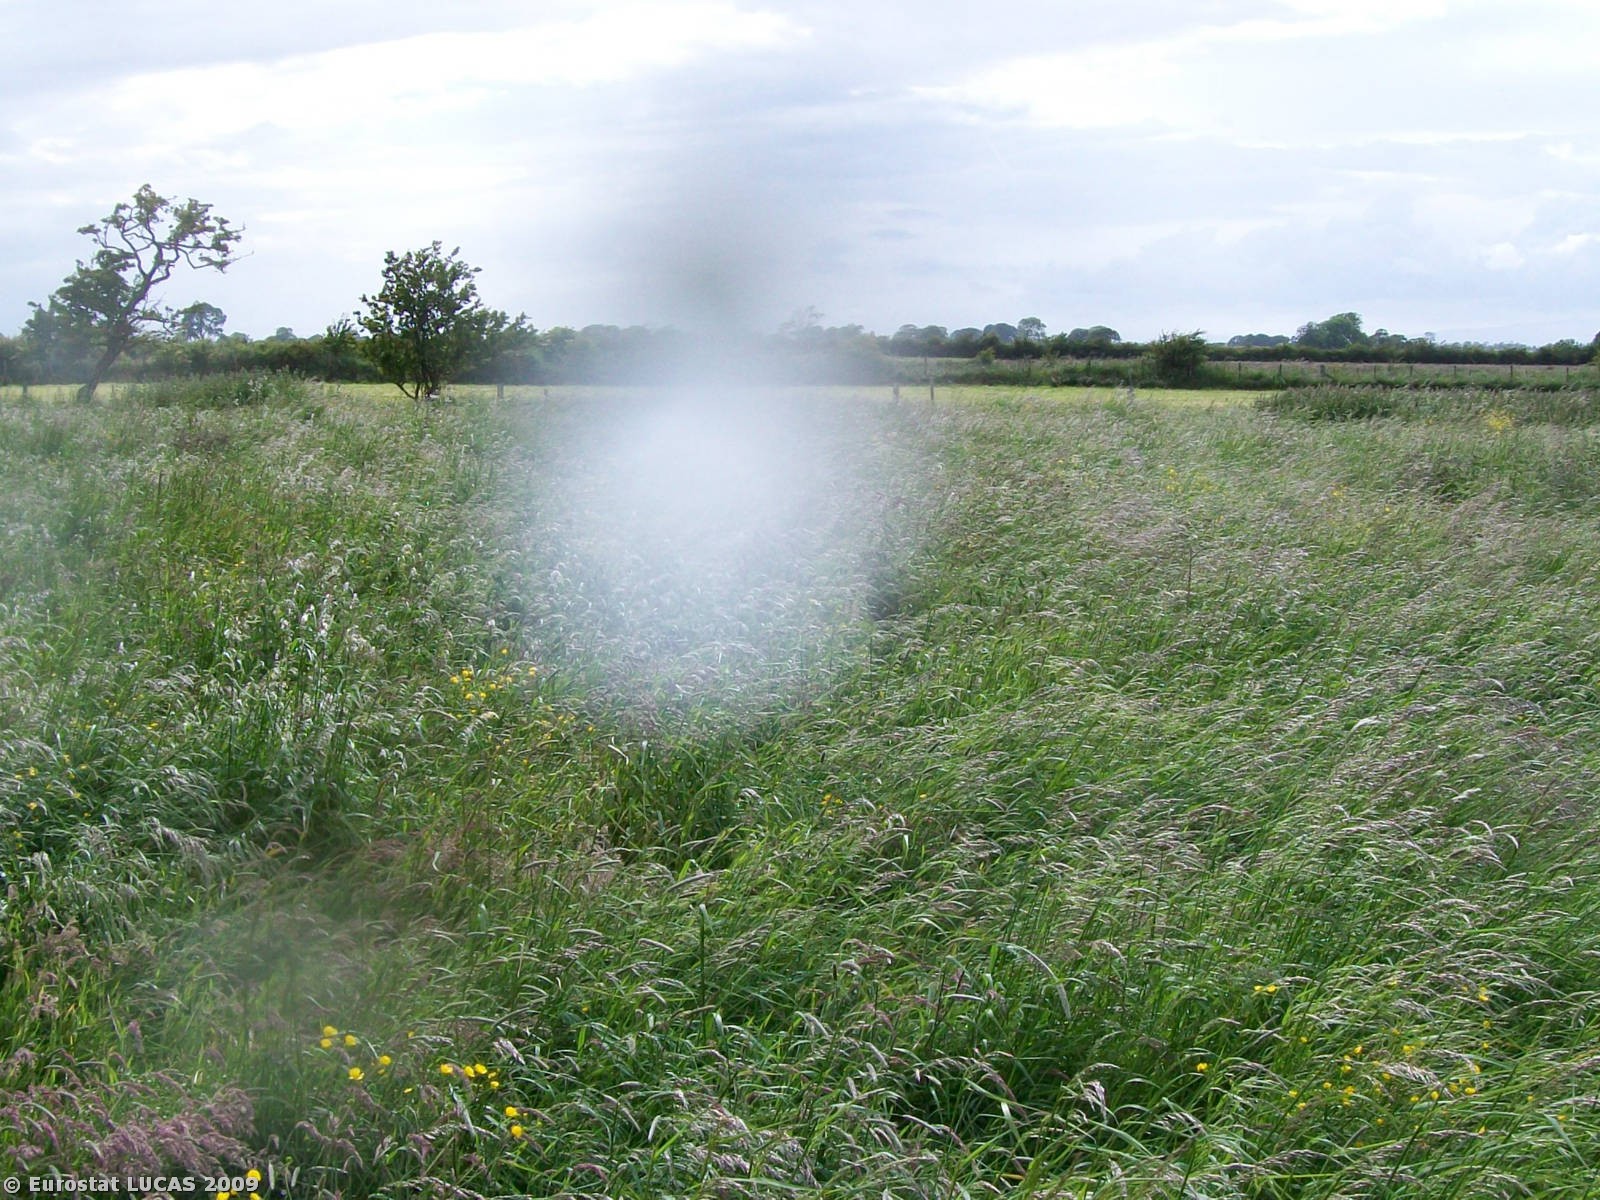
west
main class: Grassland
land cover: Grassland without tree/shrub cover
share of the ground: > 75 %
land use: Agriculture (excluding fallow land and kitchen gardens)
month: June
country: GB
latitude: 54.8448
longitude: -3.2033
